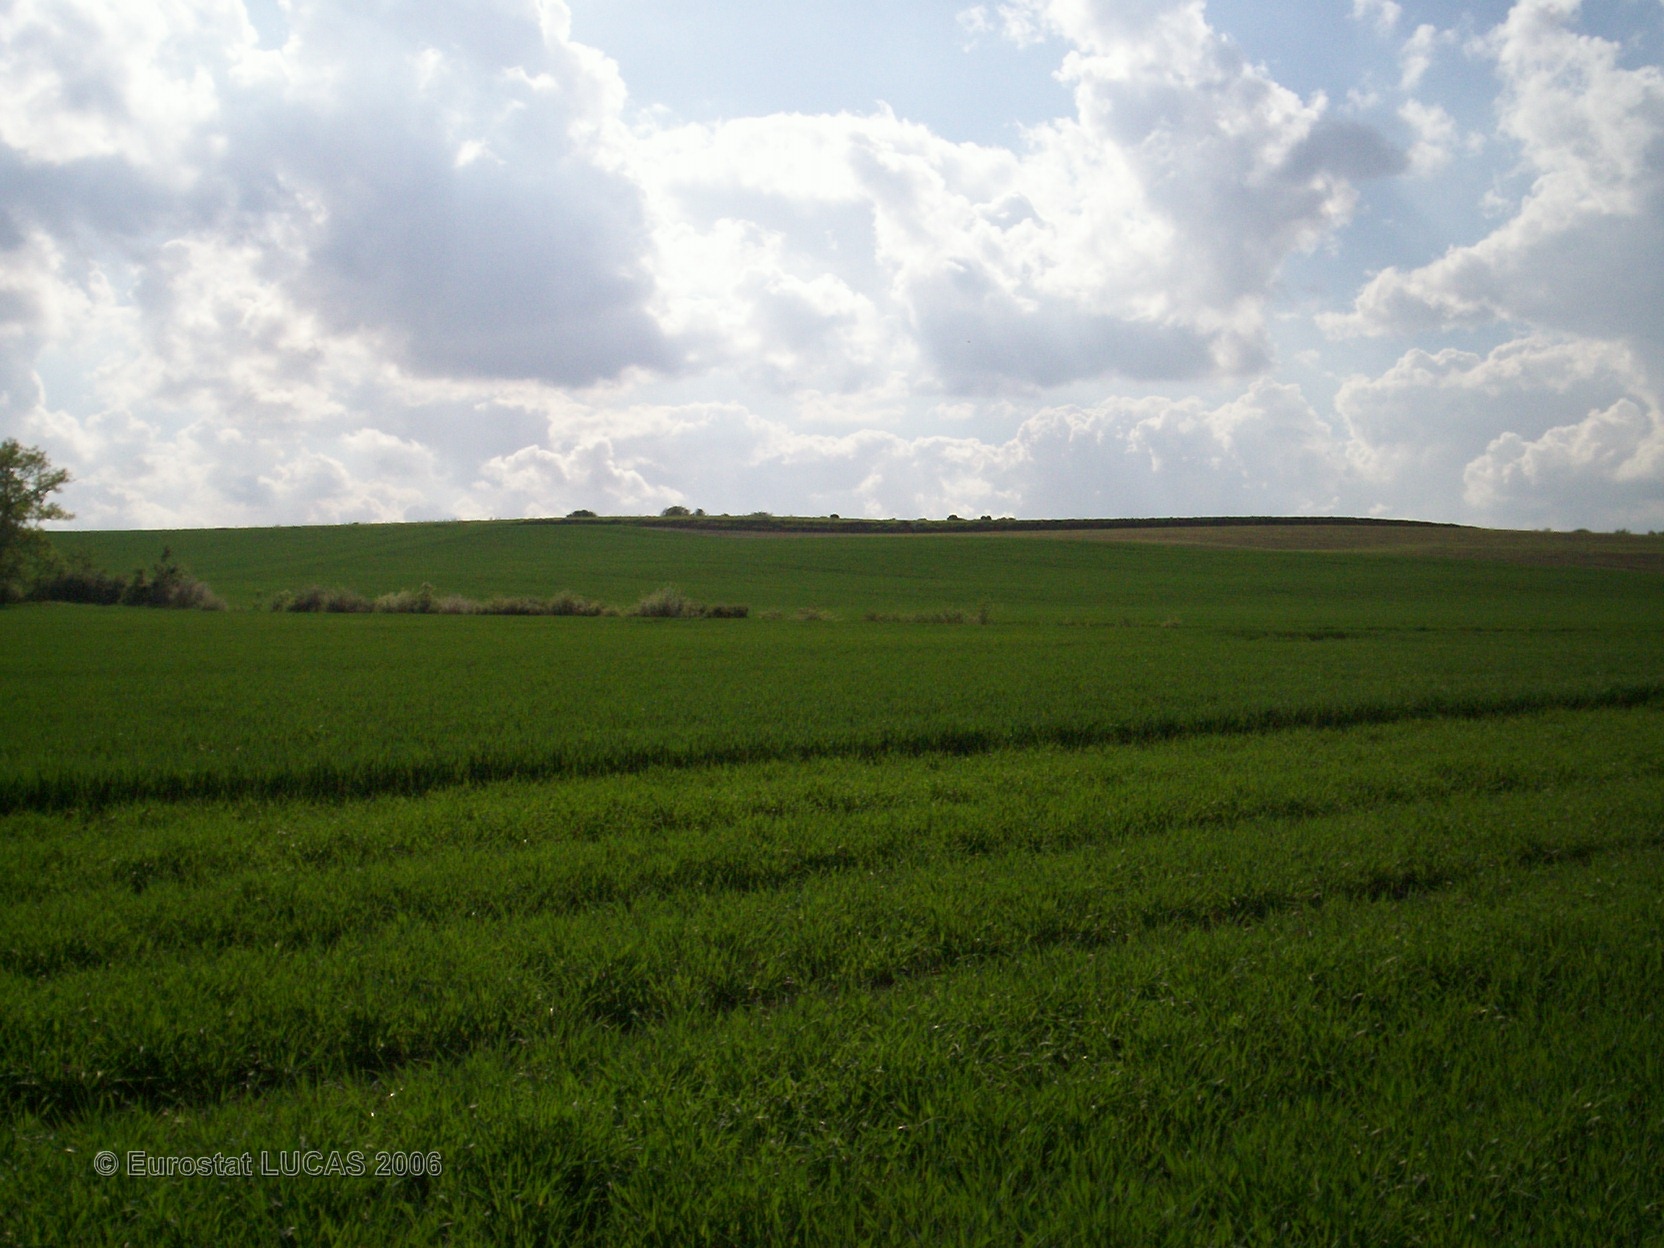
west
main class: Cropland
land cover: Barley
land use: Agriculture (excluding fallow land and kitchen gardens)
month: May
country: FR
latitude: 49.5584
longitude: 4.3693
